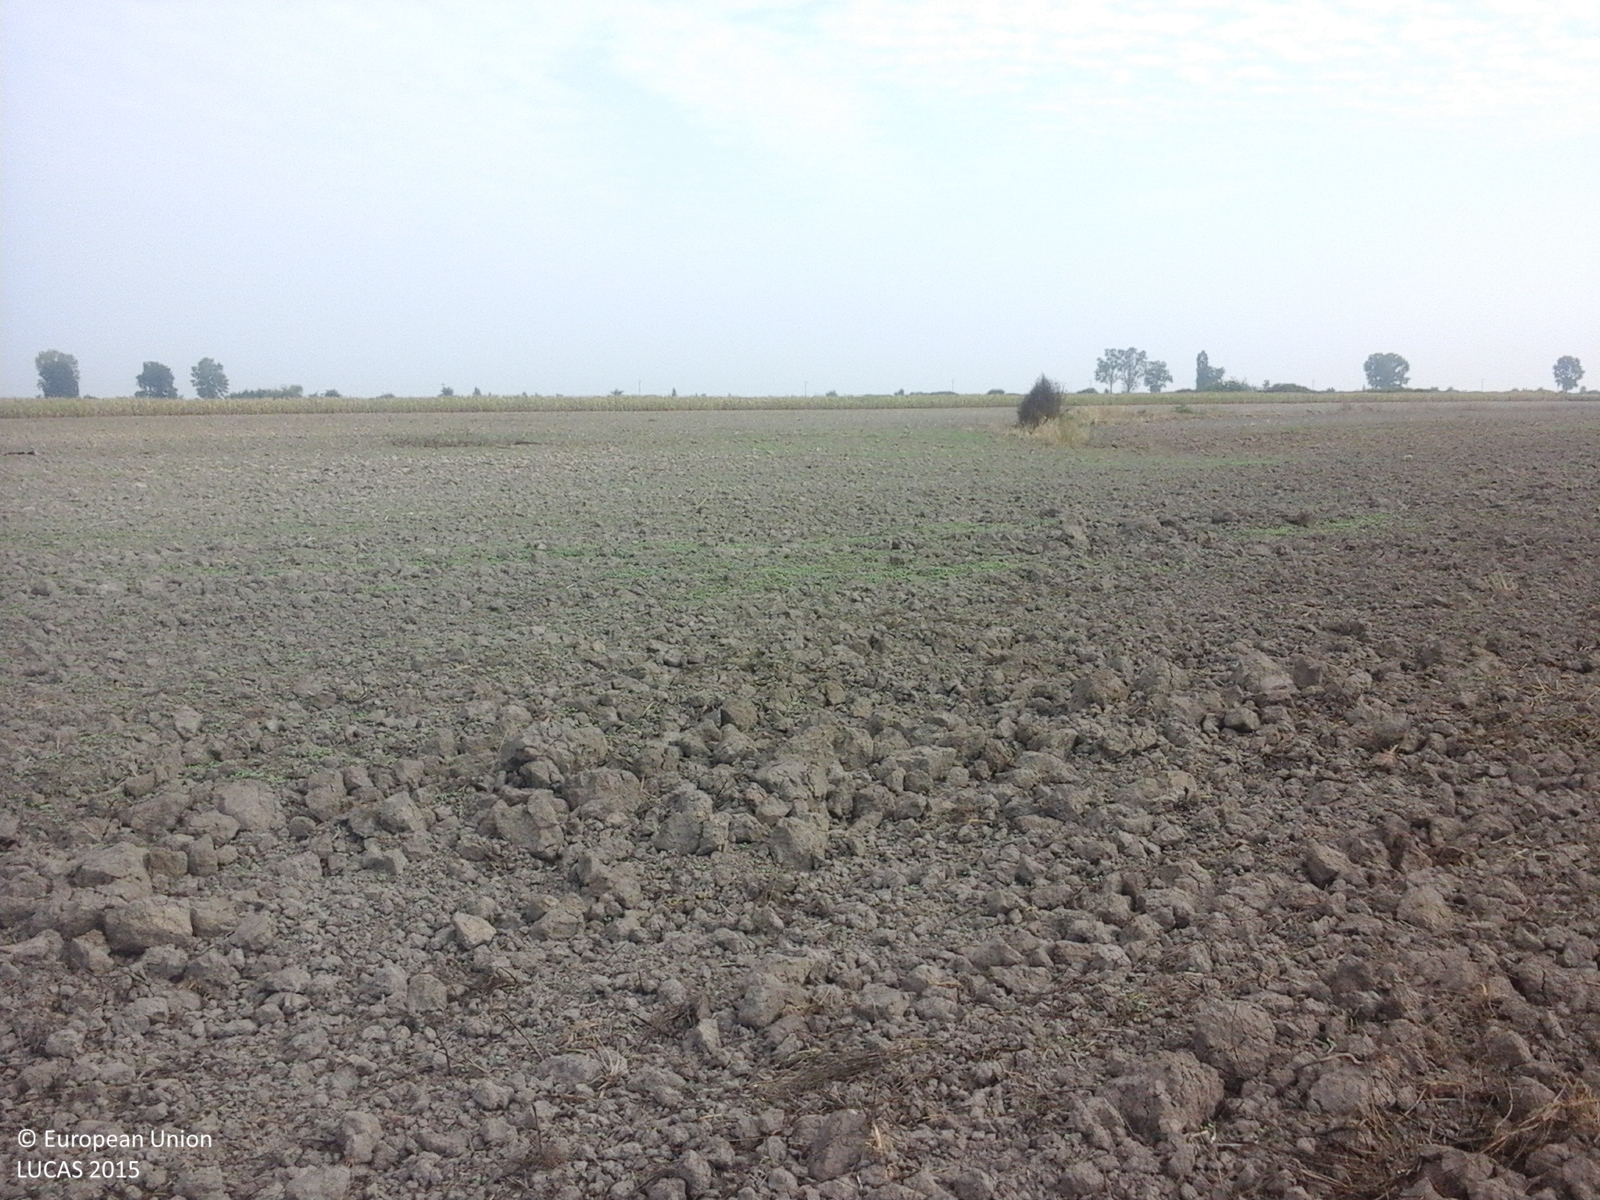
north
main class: Cropland
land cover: Common wheat
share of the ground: < 10 %
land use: Agriculture (excluding fallow land and kitchen gardens)
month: August
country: RO
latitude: 46.3916
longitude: 21.7575
